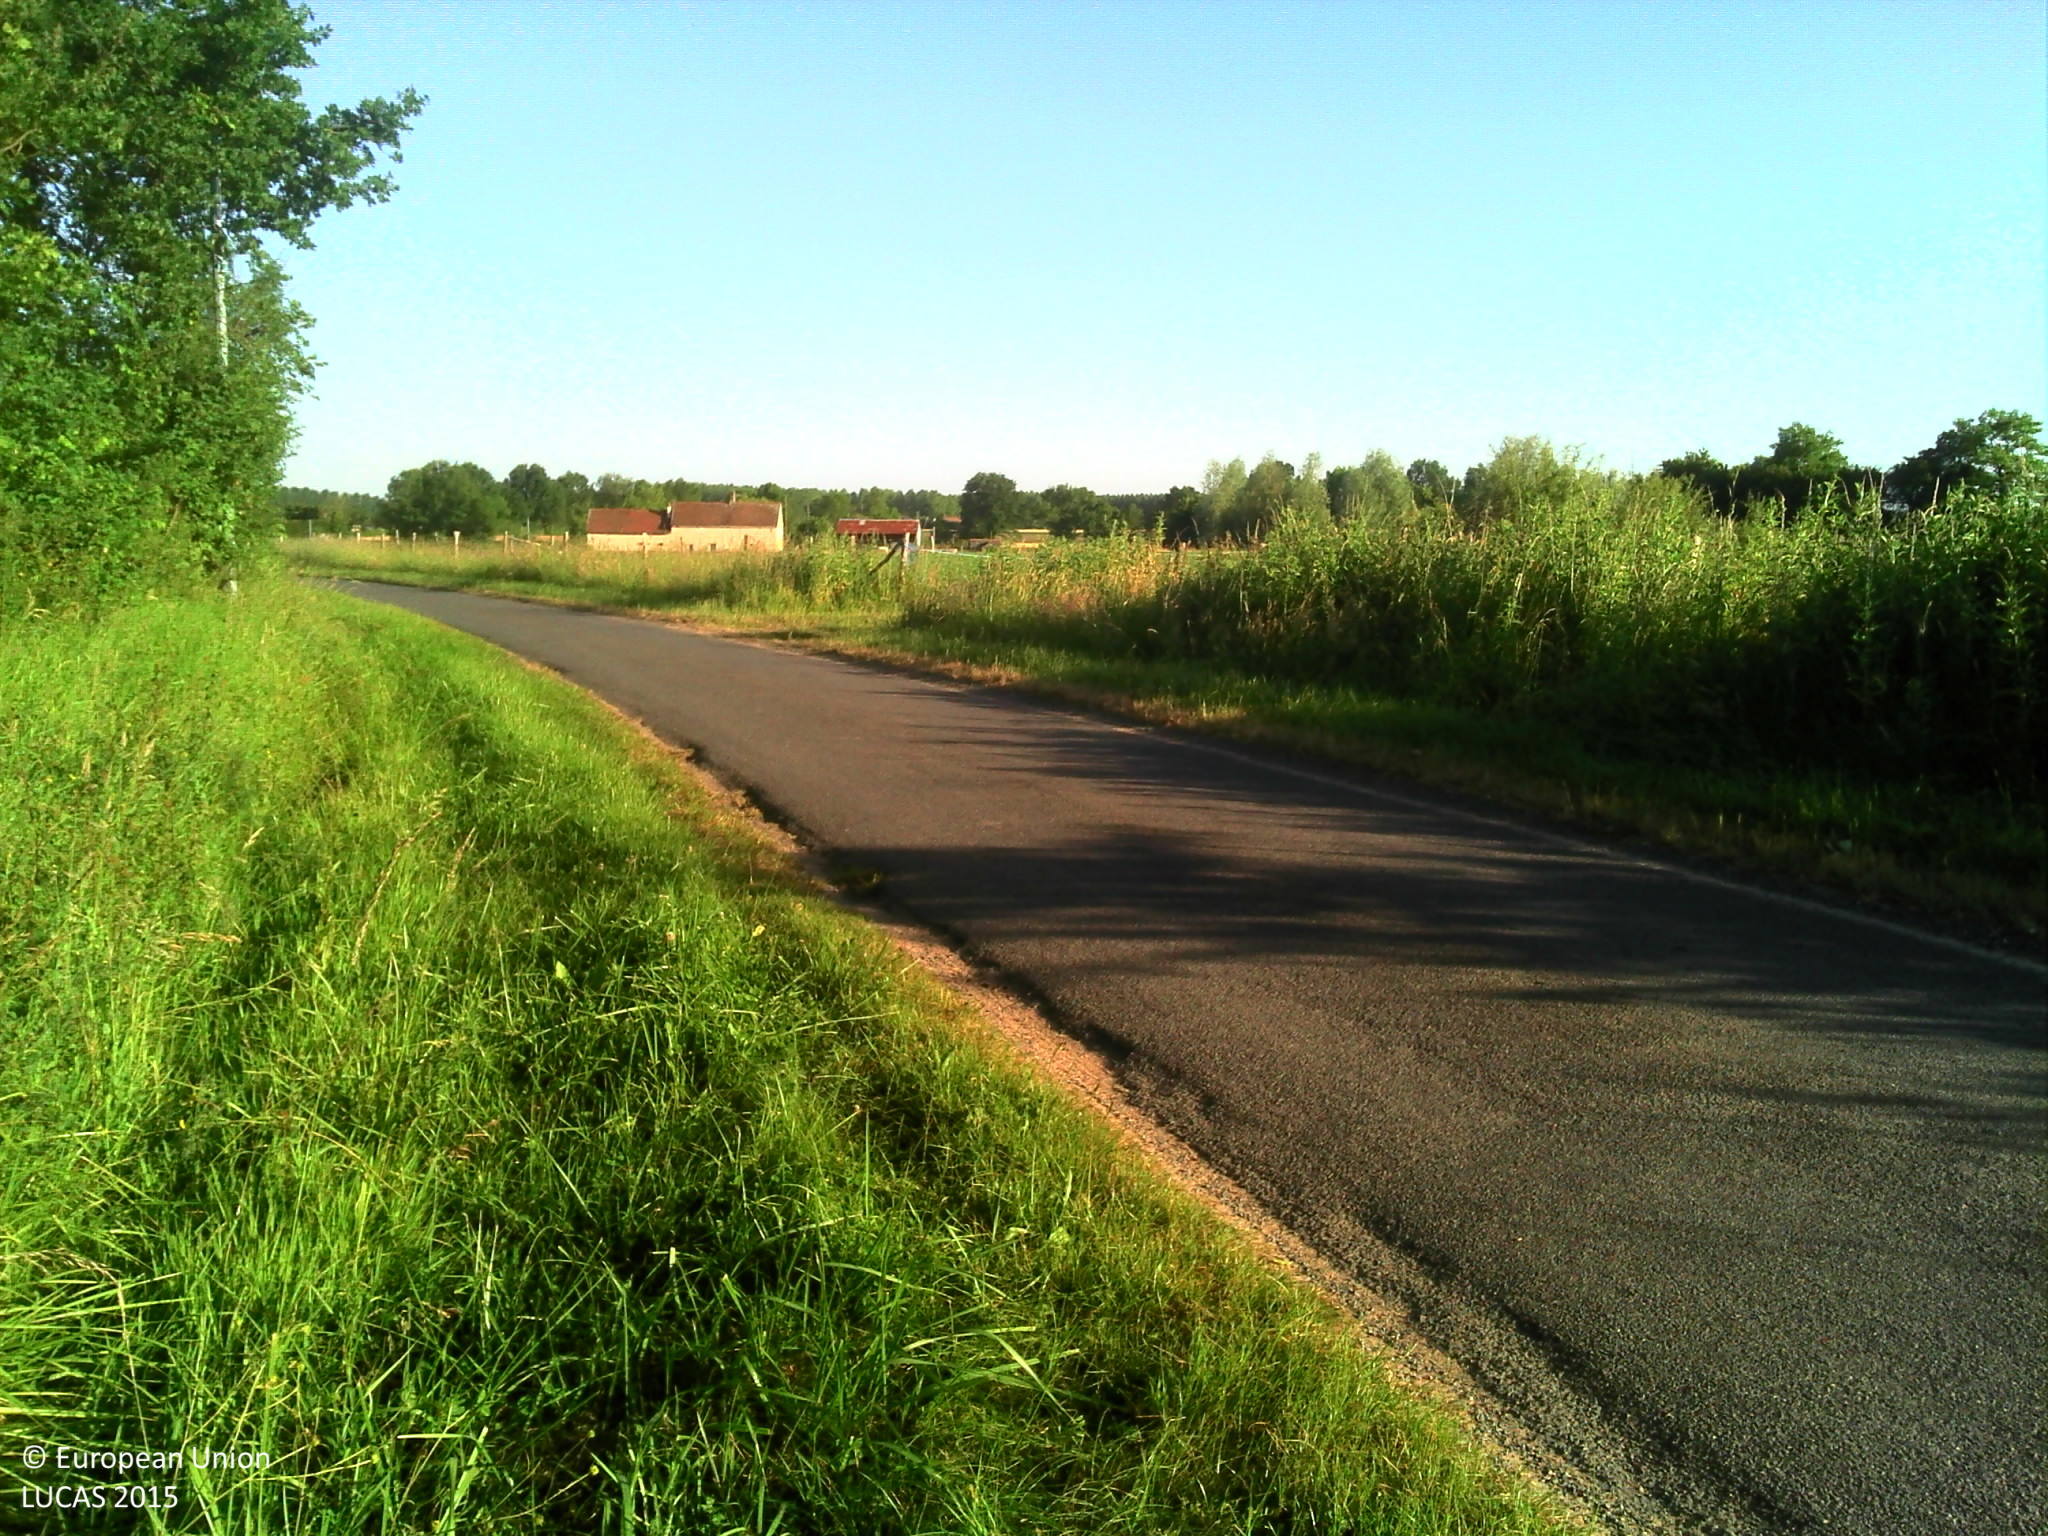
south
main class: Woodland
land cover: Broadleaved woodland
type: exotic forest
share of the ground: > 75 %
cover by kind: broadleaved forest trees 70 %, herbaceous plants 30 %
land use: Forestry
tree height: > 5 m
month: June
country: FR
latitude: 47.4346
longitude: 0.1242
